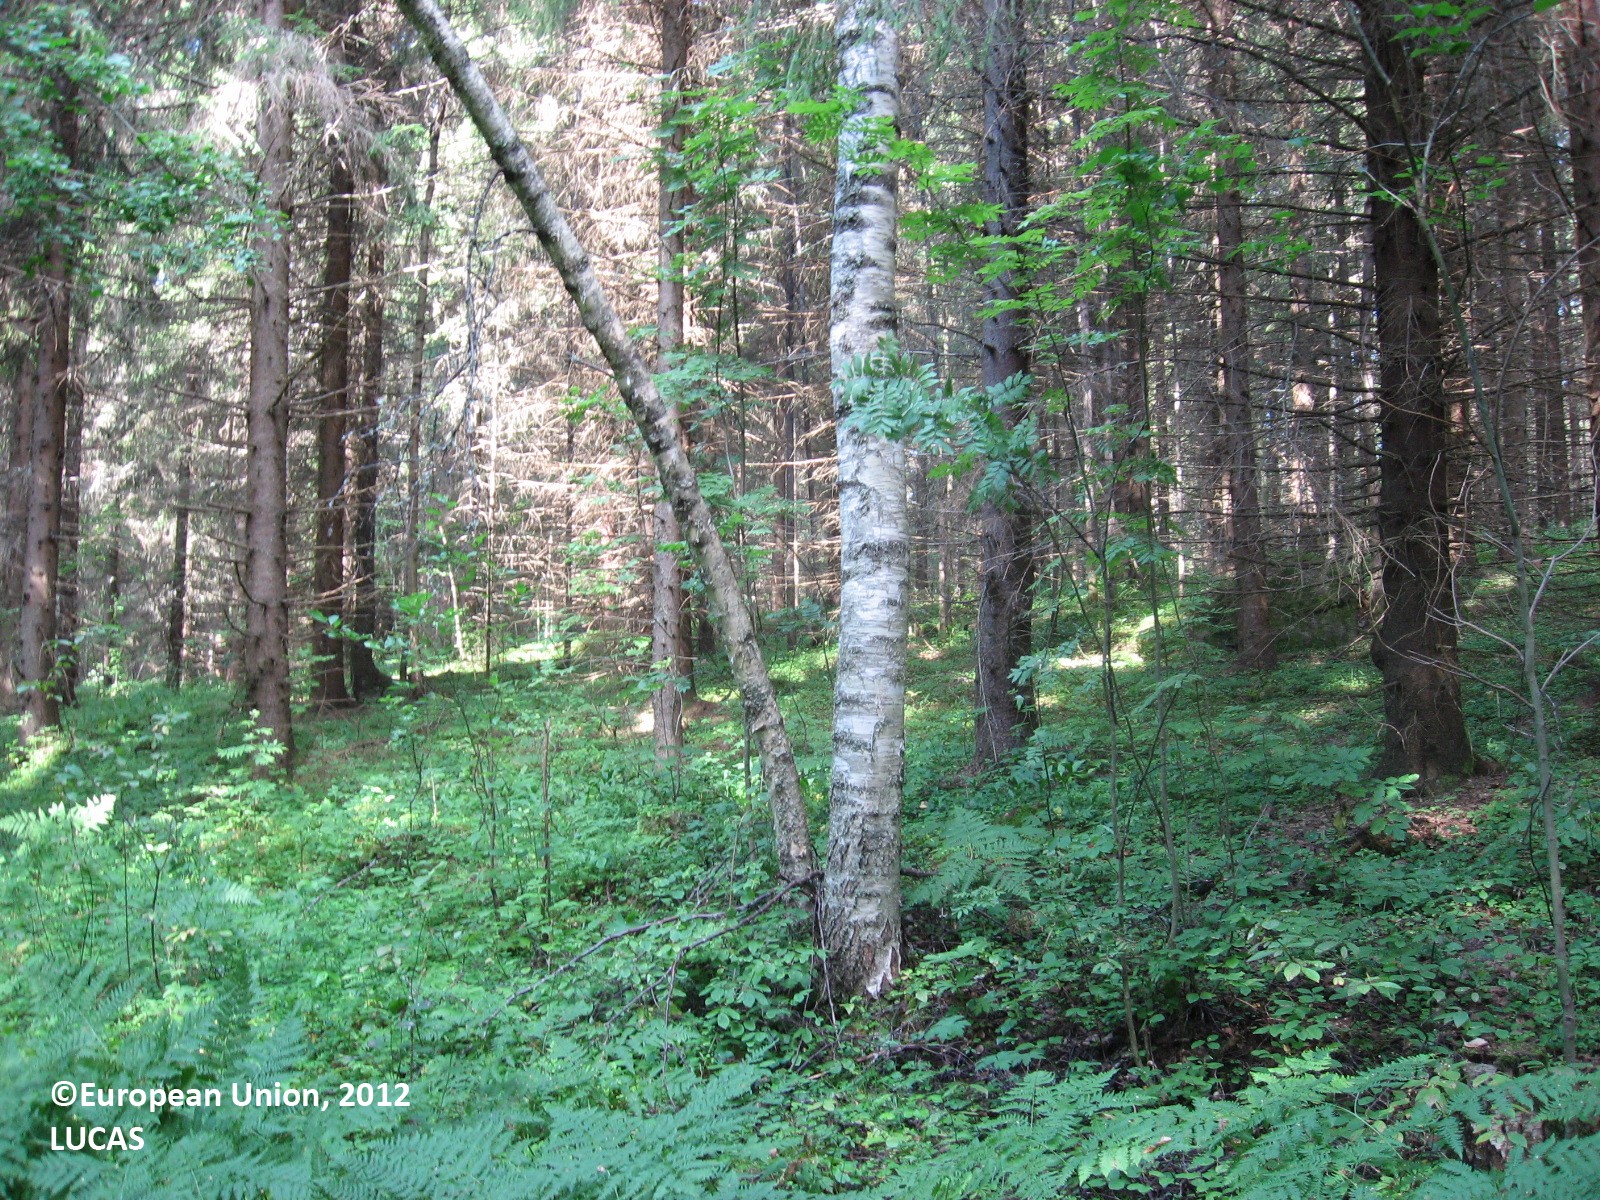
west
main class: Woodland
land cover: Spruce dominated coniferous woodland
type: boreal forest
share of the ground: > 75 %
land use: Forestry
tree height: > 5 m
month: August
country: FI
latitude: 61.5403
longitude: 25.8750
